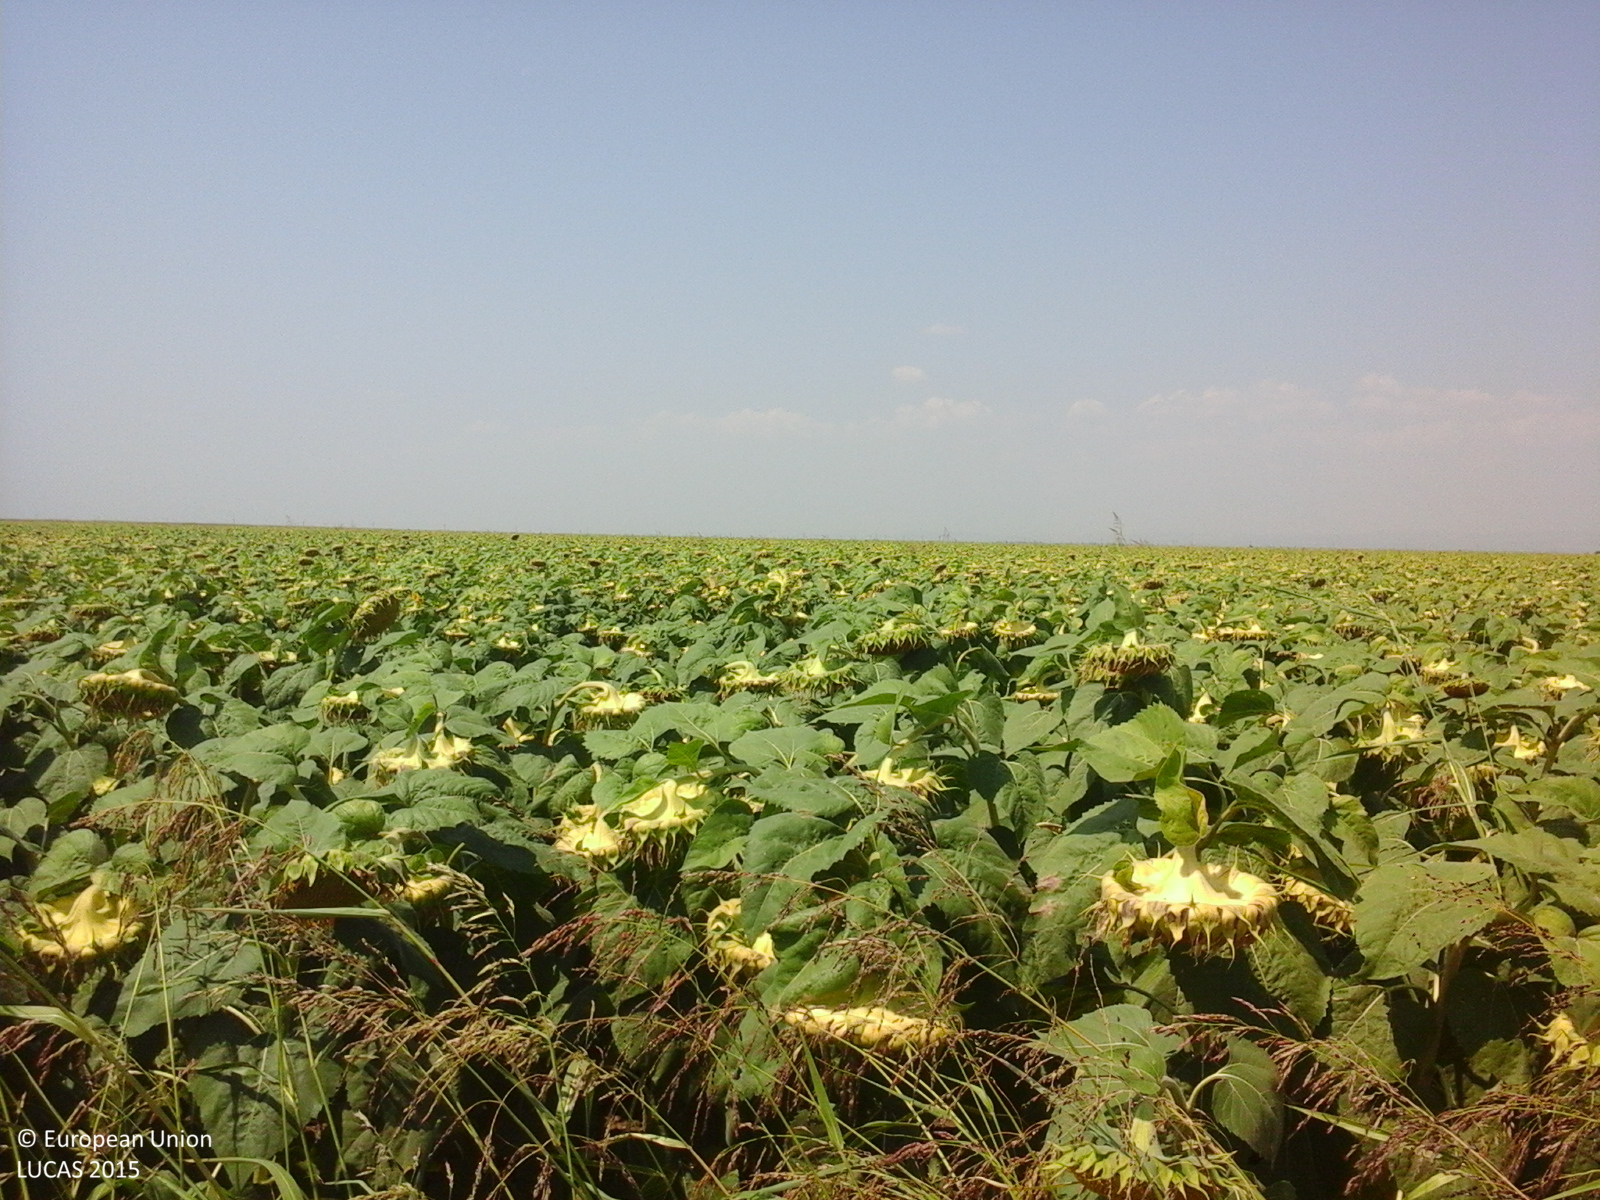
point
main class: Cropland
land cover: Sunflower
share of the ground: > 75 %
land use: Agriculture (excluding fallow land and kitchen gardens)
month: August
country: RO
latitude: 44.9325
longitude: 26.7120
